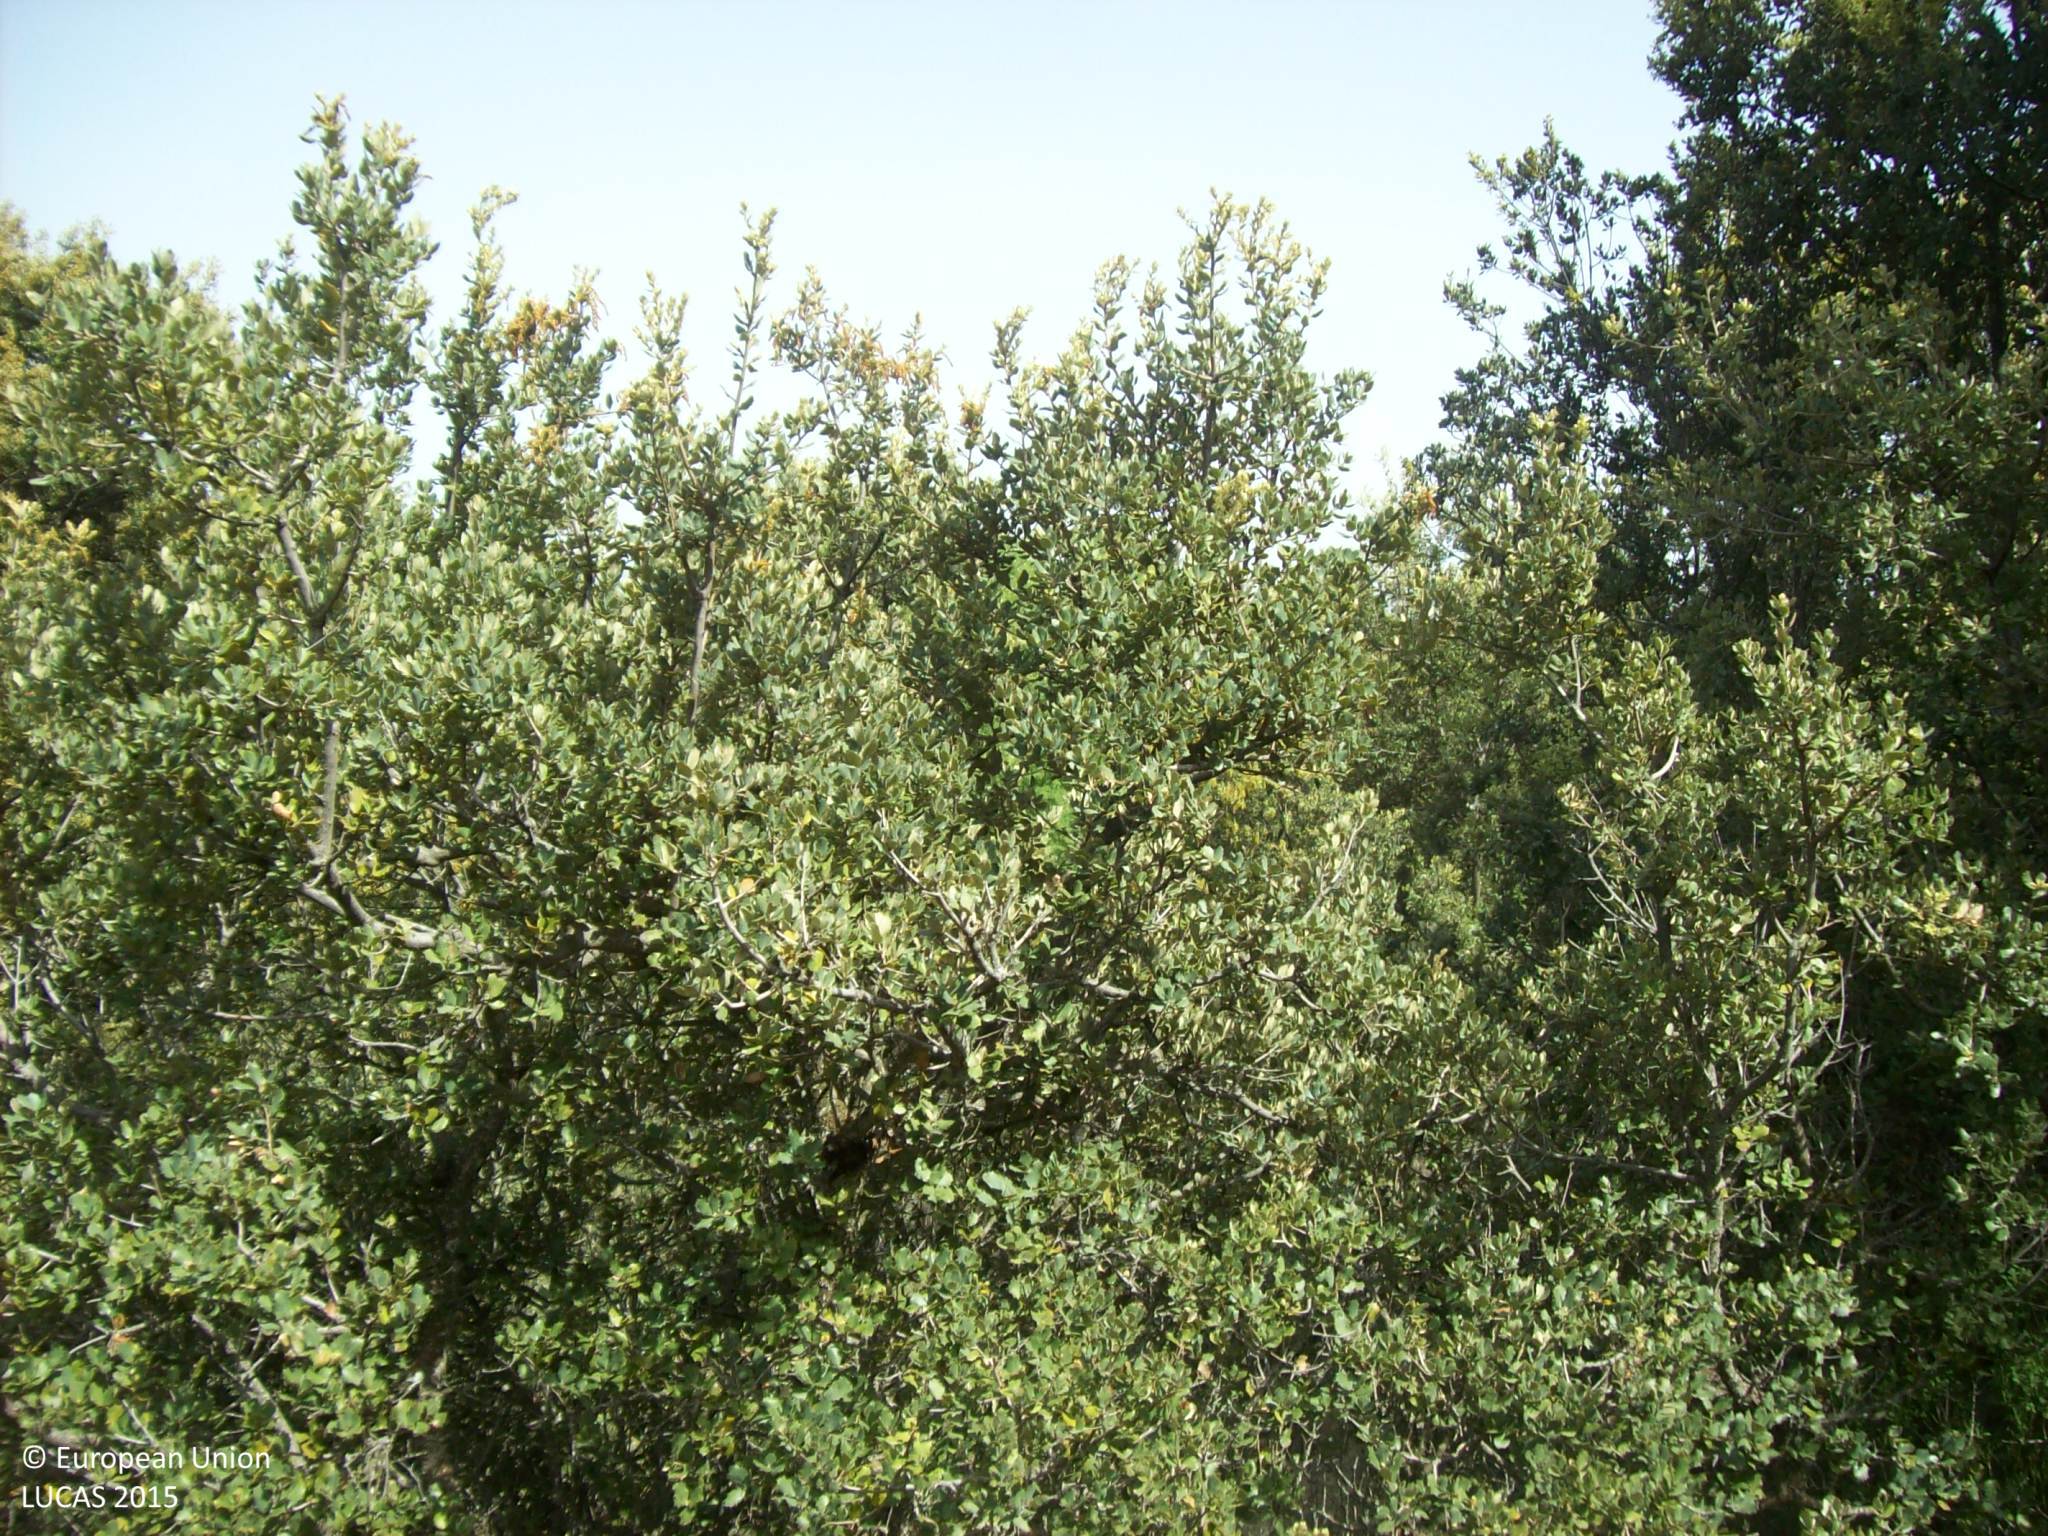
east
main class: Woodland
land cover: Broadleaved woodland
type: broadleaved evergreen forest
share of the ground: 25 - 50 %
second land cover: Shrubland without tree cover
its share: 10 - 25 %
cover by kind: broadleaved forest trees 40 %, shrubs 20 %, unconsolidated bare surface 20 %, herbaceous plants 10 %, consolidated bare surface 10 %
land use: Forestry
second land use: Agriculture (excluding fallow land and kitchen gardens)
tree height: < 5 m
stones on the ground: 10 - 25 %
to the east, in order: Broadleaved woodland; Shrubland without tree cover; Dry stone walls; Pine dominated mixed woodland; Broadleaved woodland; Rivers and streams; Broadleaved woodland; Grassland with sparse tree/shrub cover; Tracks; Electric lines; Grass margins; Fences; Grassland without tree/shrub cover
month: May
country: ES
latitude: 40.6320
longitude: -4.8723
